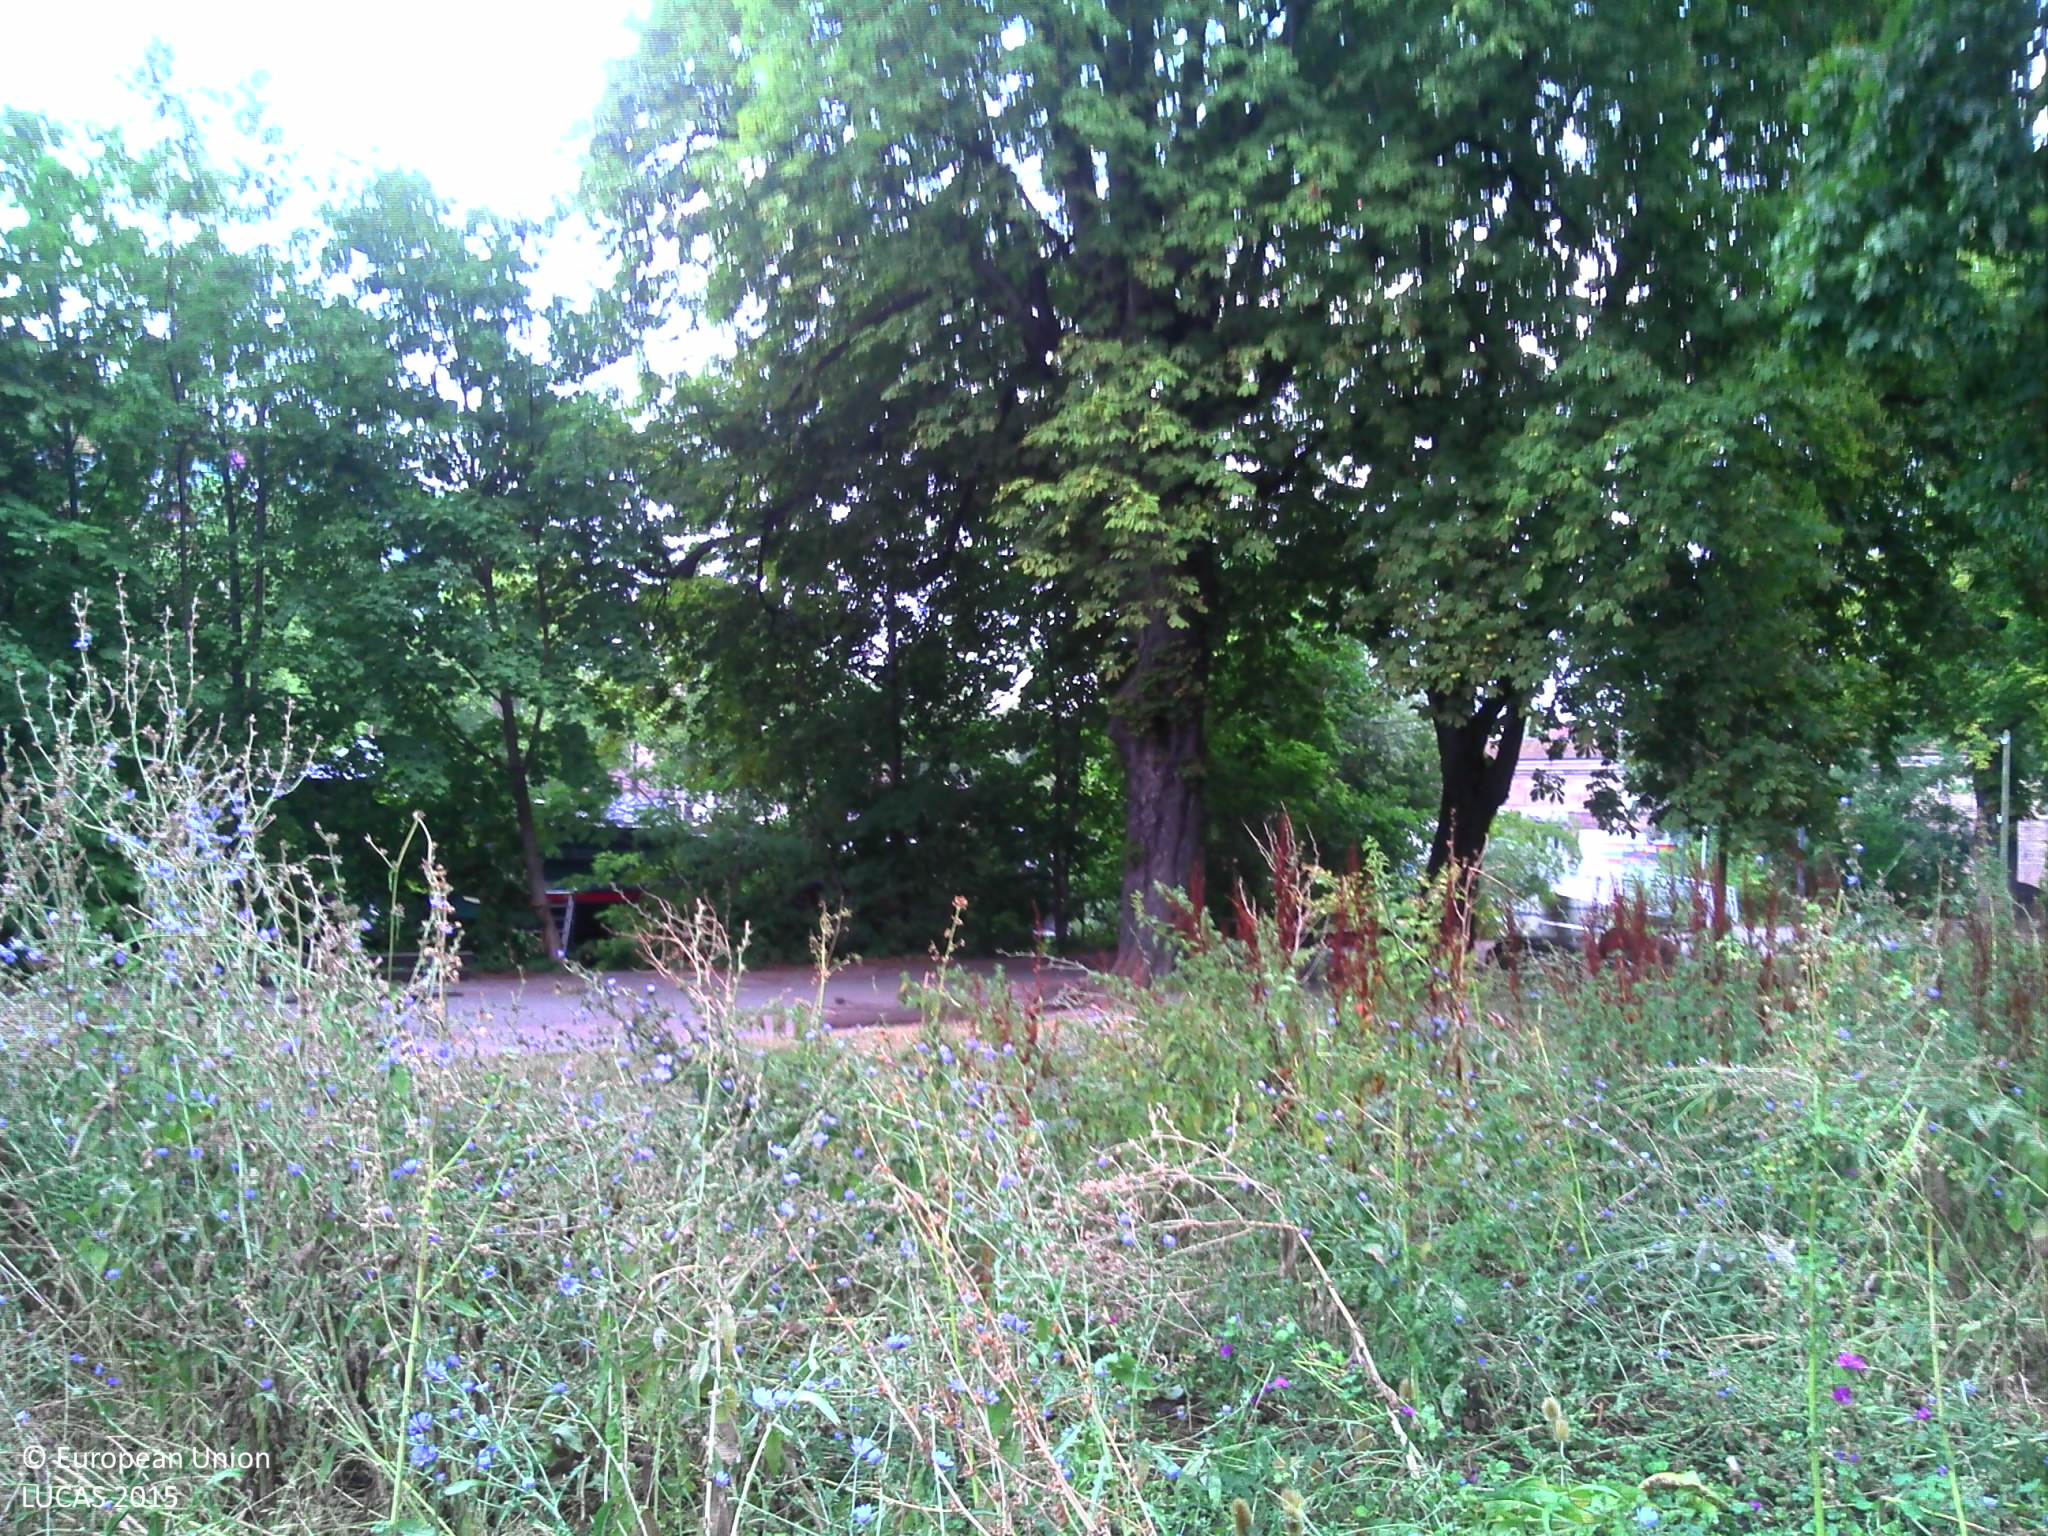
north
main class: Grassland
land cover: Spontaneously vegetated surfaces
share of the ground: > 75 %
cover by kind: herbaceous plants 100 %
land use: Community services
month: August
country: FR
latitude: 48.5784
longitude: 7.7372
